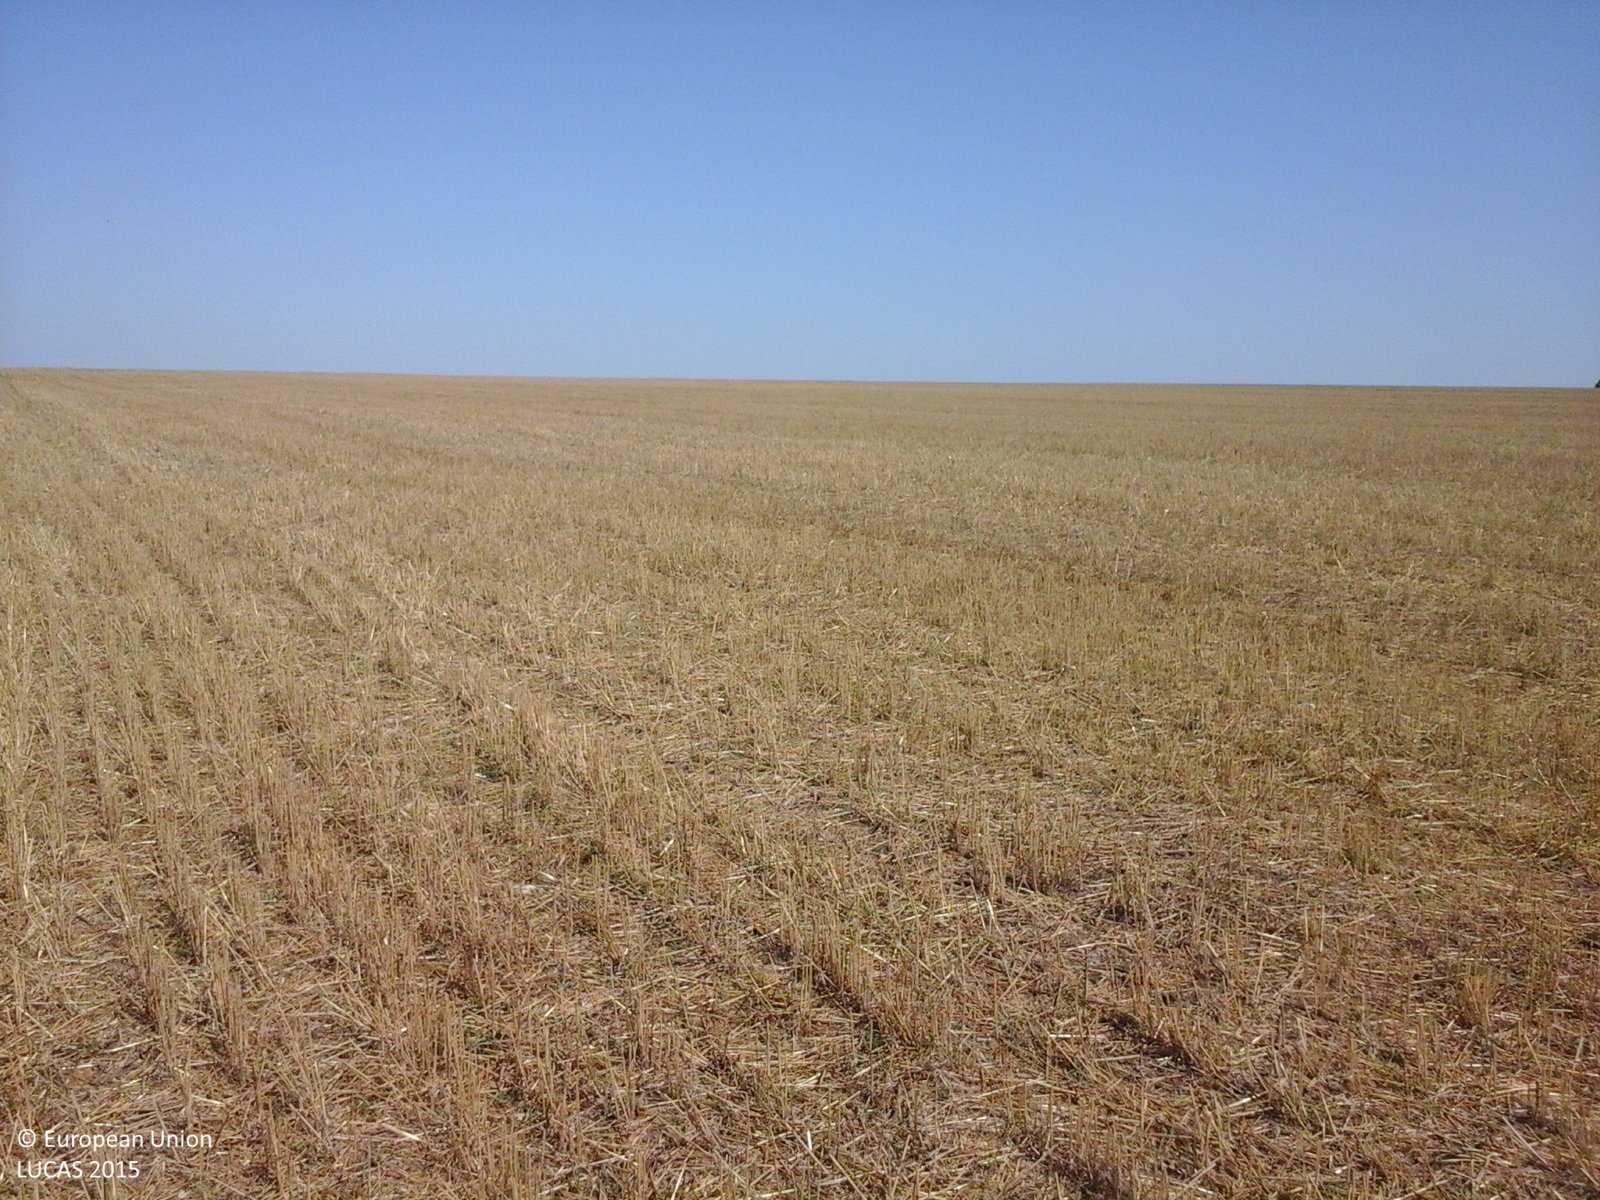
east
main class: Cropland
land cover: Common wheat
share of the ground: 10 - 25 %
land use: Agriculture (excluding fallow land and kitchen gardens)
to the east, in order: Common wheat
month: August
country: RO
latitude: 44.4456
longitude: 28.4801
